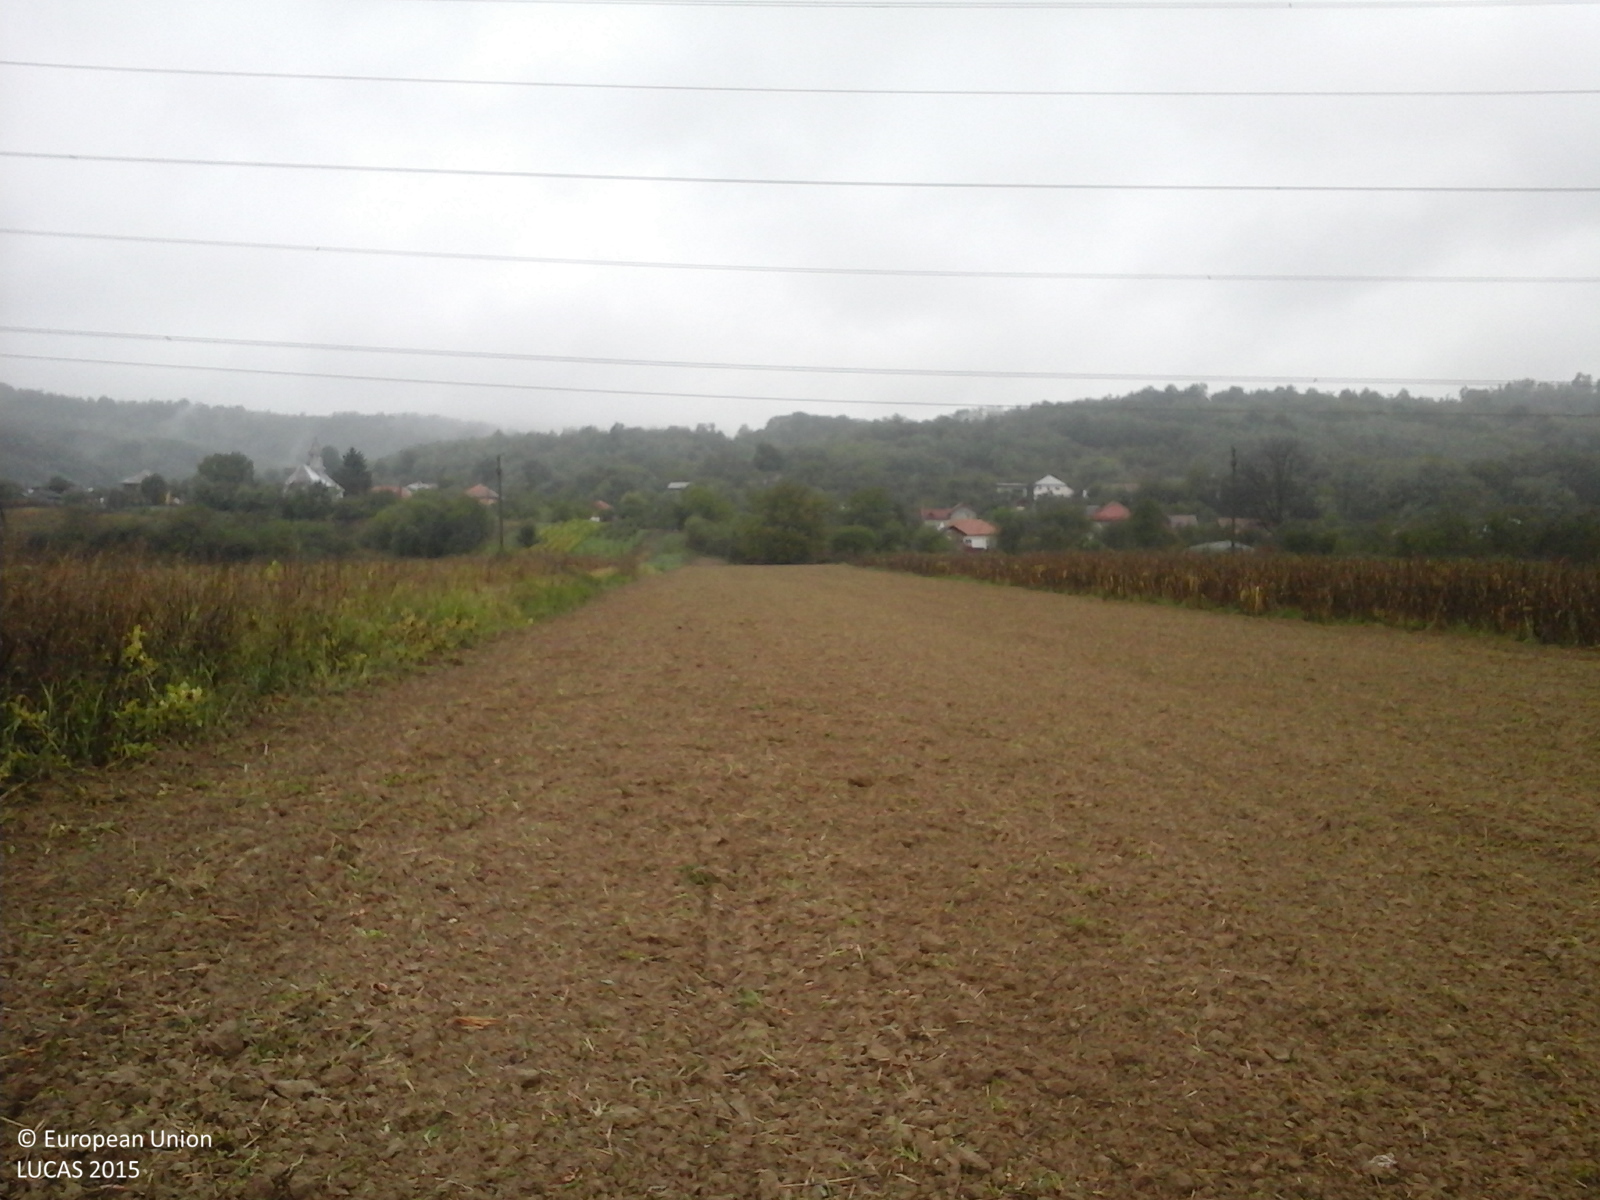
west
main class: Cropland
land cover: Common wheat
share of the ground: < 10 %
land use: Agriculture (excluding fallow land and kitchen gardens)
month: September
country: RO
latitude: 44.8686
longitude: 23.5108
